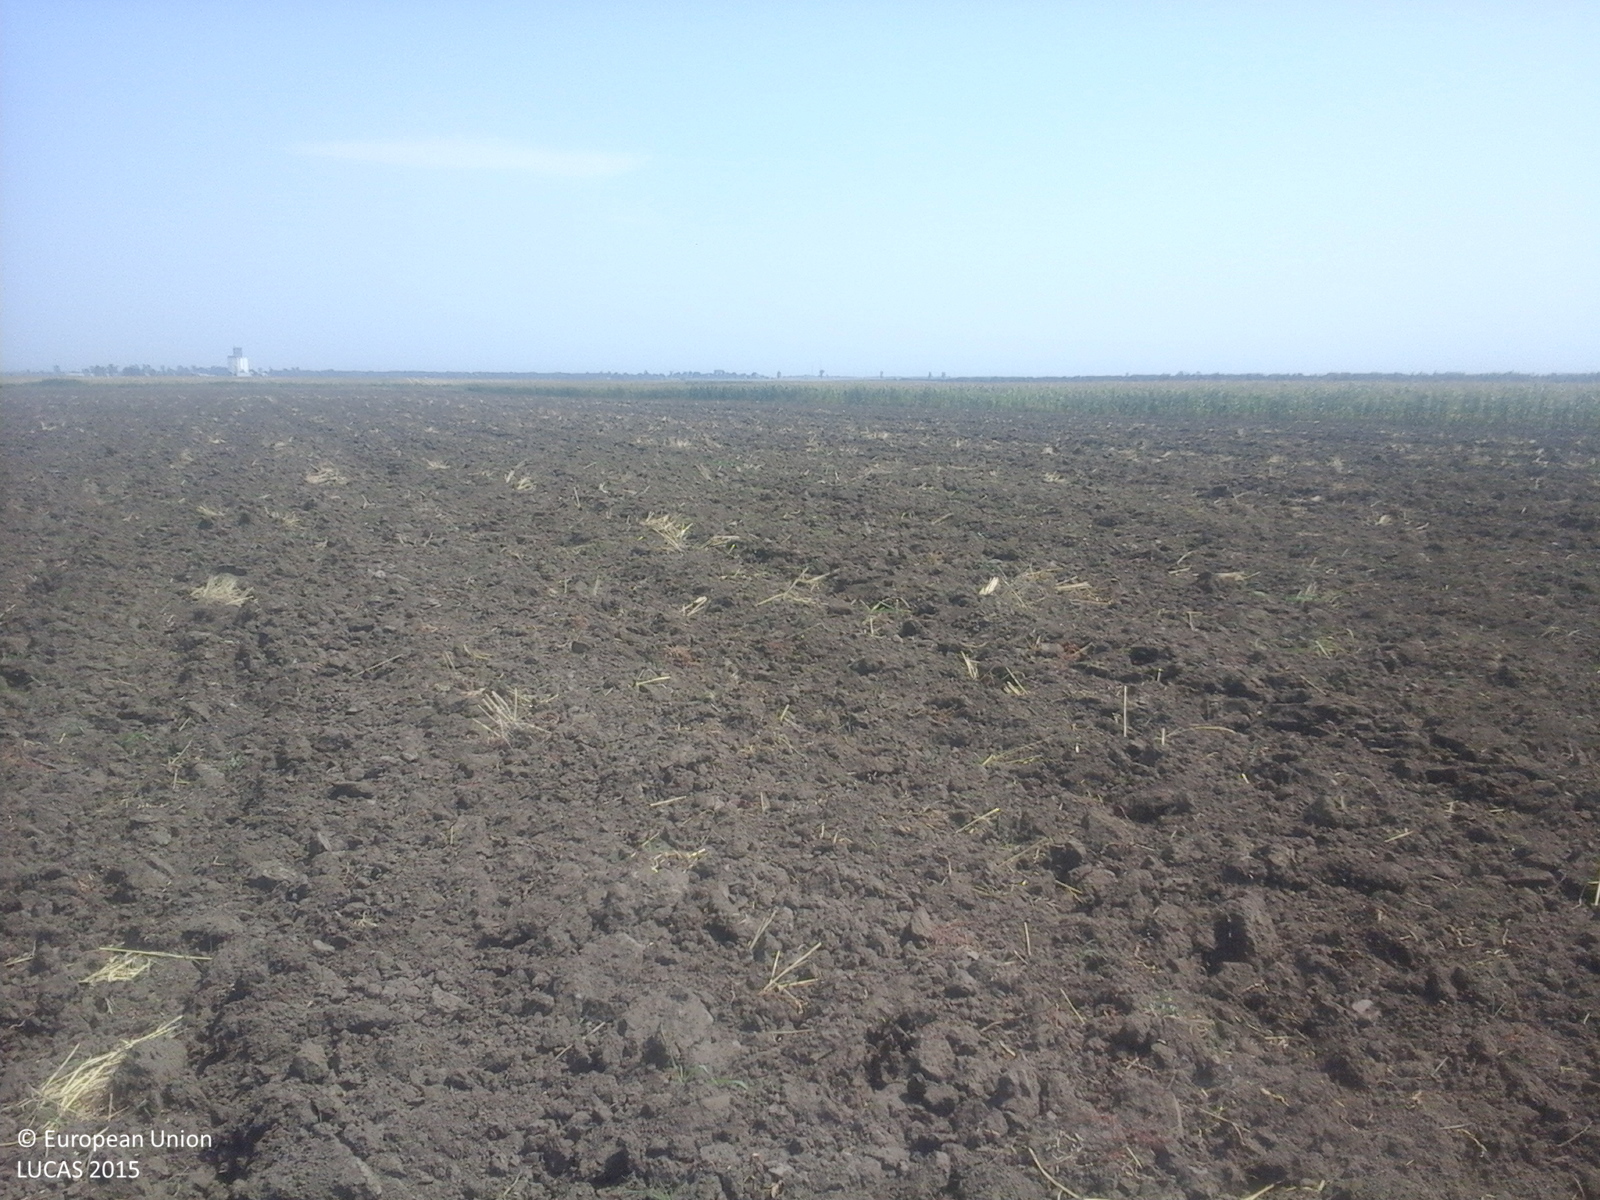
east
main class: Cropland
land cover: Common wheat
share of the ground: < 10 %
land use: Agriculture (excluding fallow land and kitchen gardens)
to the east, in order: Common wheat; Maize
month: August
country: RO
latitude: 45.1767
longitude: 27.6779
